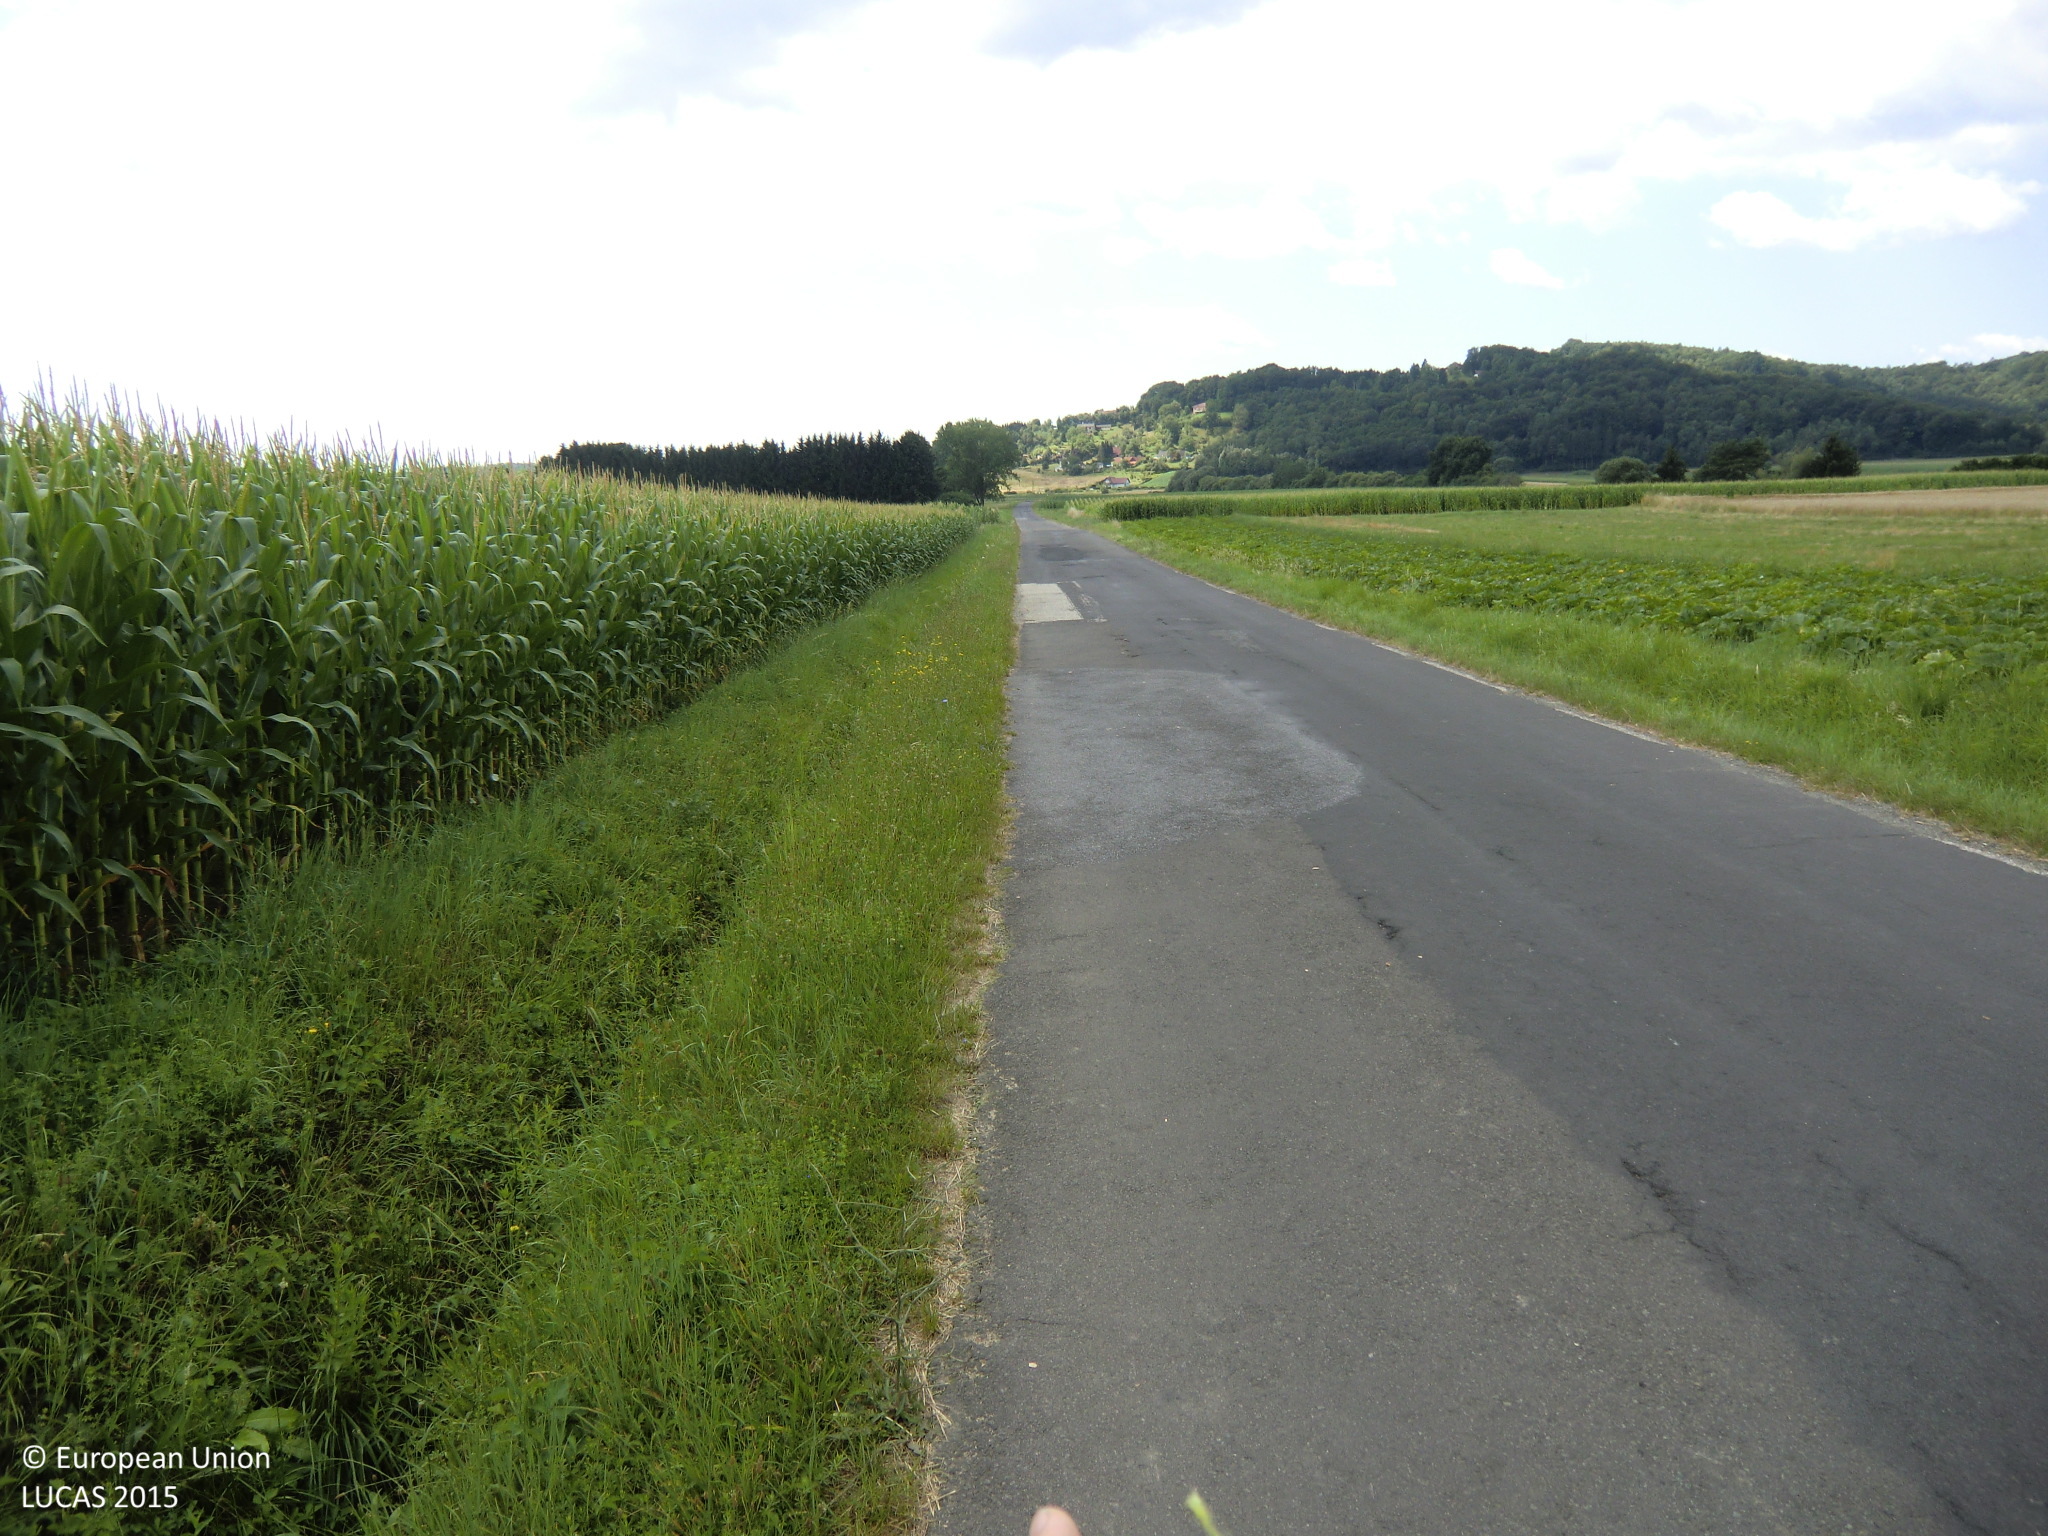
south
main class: Cropland
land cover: Maize
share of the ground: > 75 %
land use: Agriculture (excluding fallow land and kitchen gardens)
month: July
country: AT
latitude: 46.9515
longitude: 16.1373
